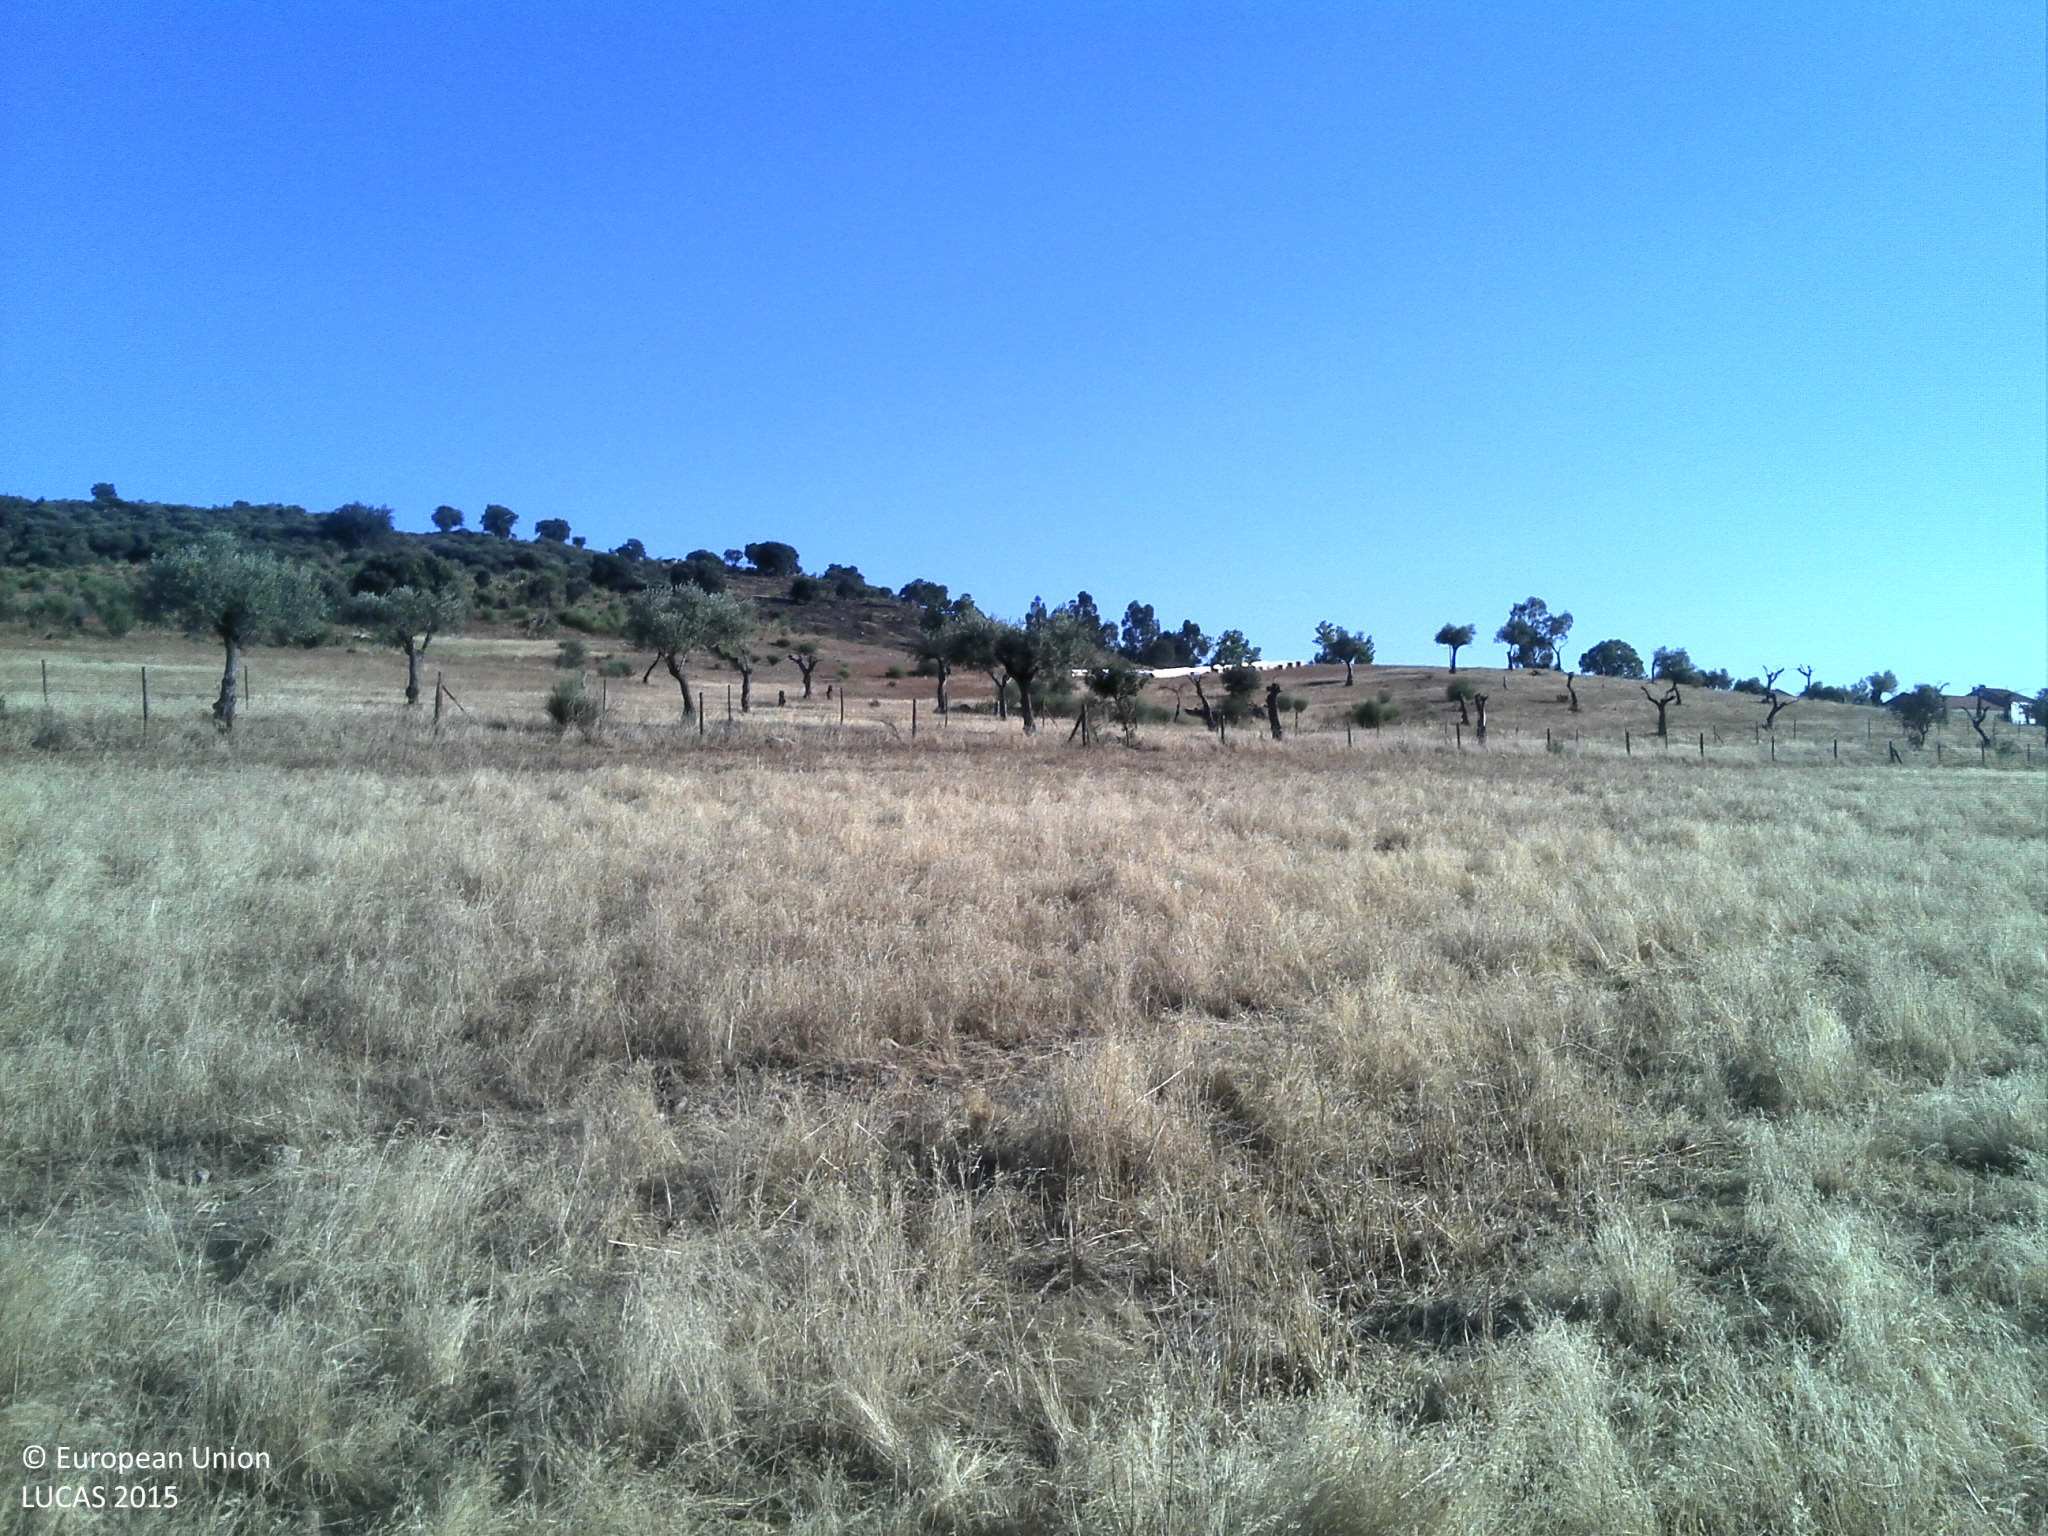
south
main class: Grassland
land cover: Grassland without tree/shrub cover
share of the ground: 50 - 75 %
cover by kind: herbaceous plants 60 %, unconsolidated bare surface 35 %
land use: Agriculture (excluding fallow land and kitchen gardens)
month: June
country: PT
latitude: 39.9901
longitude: -7.3017
